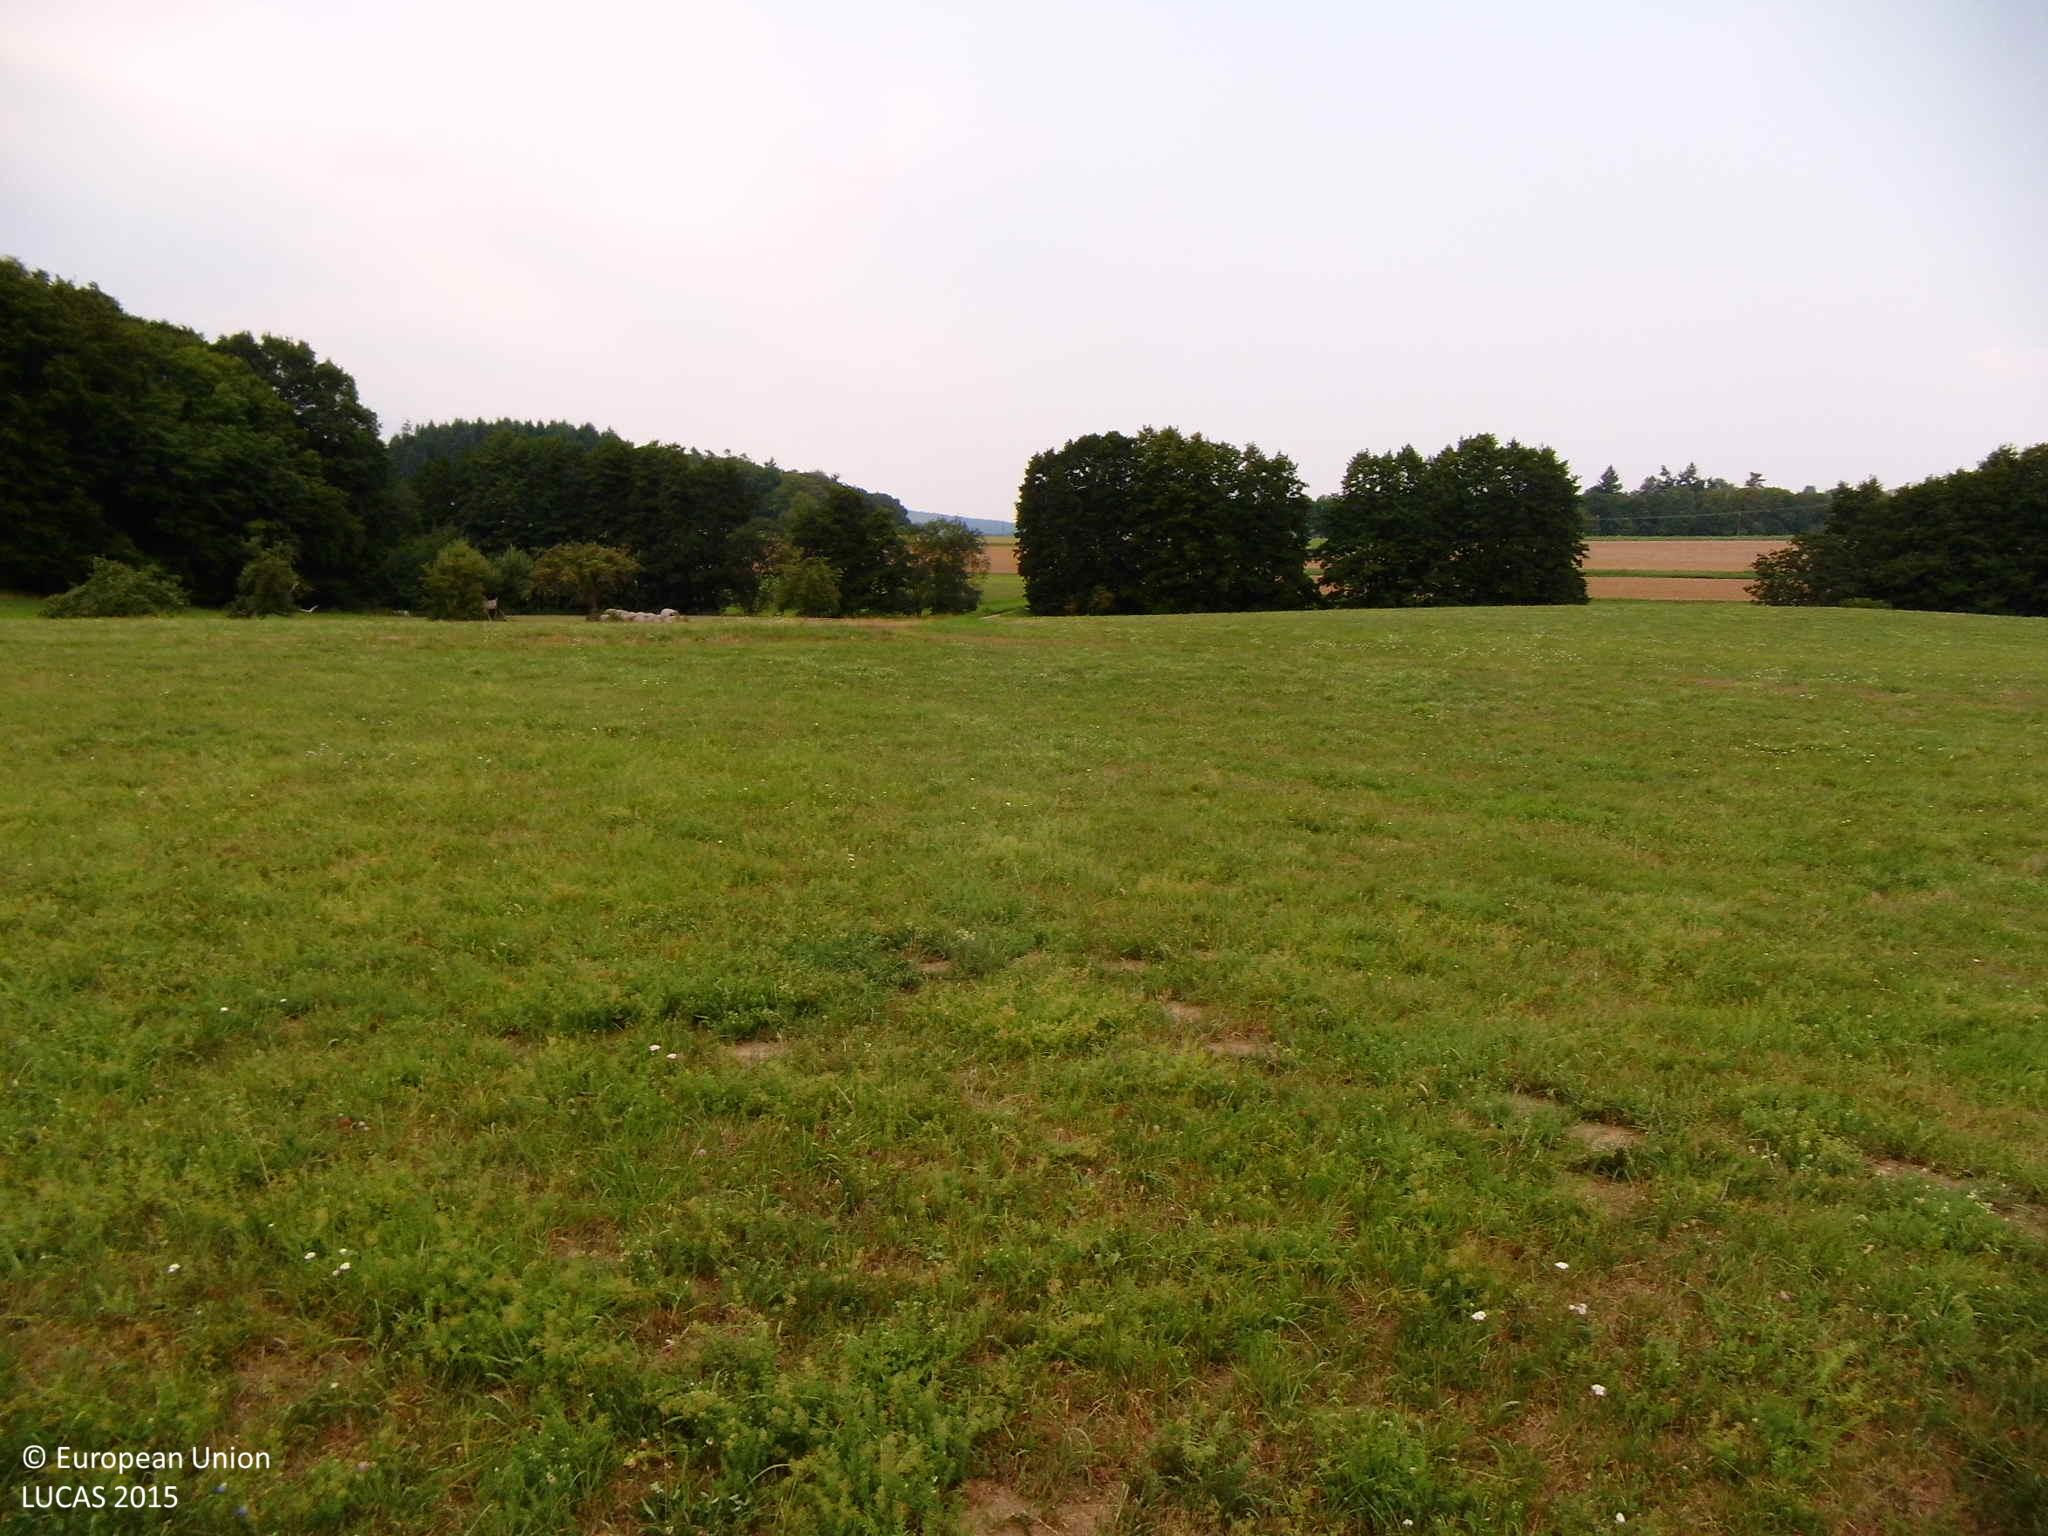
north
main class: Grassland
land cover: Grassland without tree/shrub cover
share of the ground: > 75 %
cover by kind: herbaceous plants 100 %
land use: Agriculture (excluding fallow land and kitchen gardens)
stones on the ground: < 10 %
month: August
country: DE
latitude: 50.6073
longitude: 8.6014
